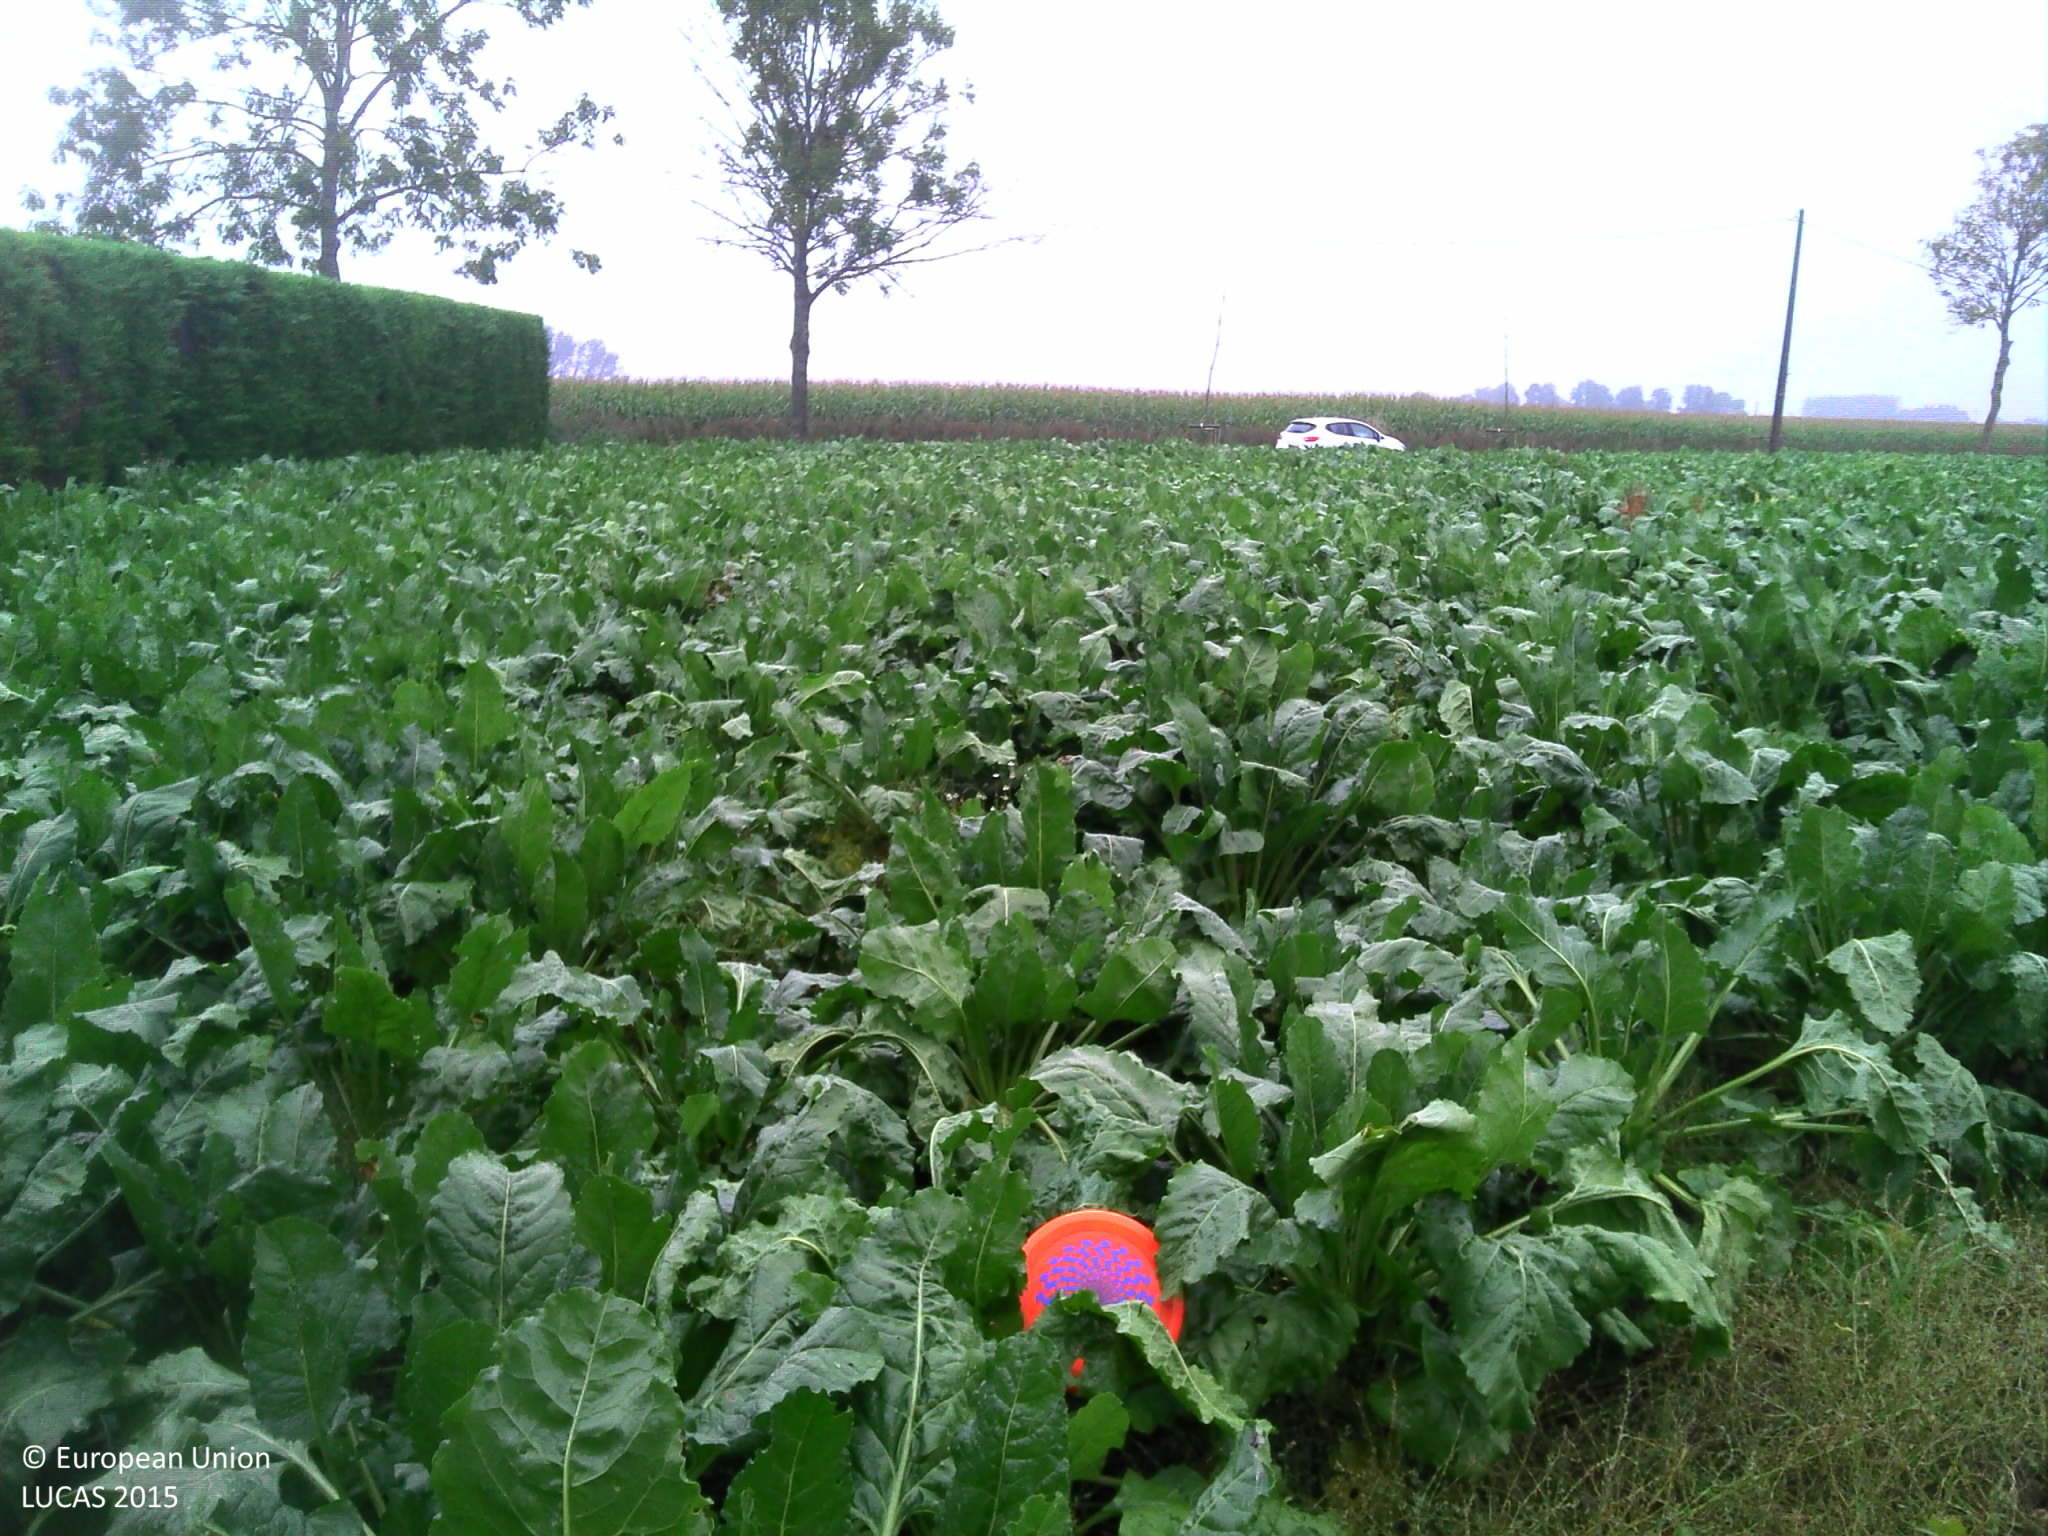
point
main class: Cropland
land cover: Sugar beet
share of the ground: > 75 %
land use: Agriculture (excluding fallow land and kitchen gardens)
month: September
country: BE
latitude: 51.1103
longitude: 2.7754
